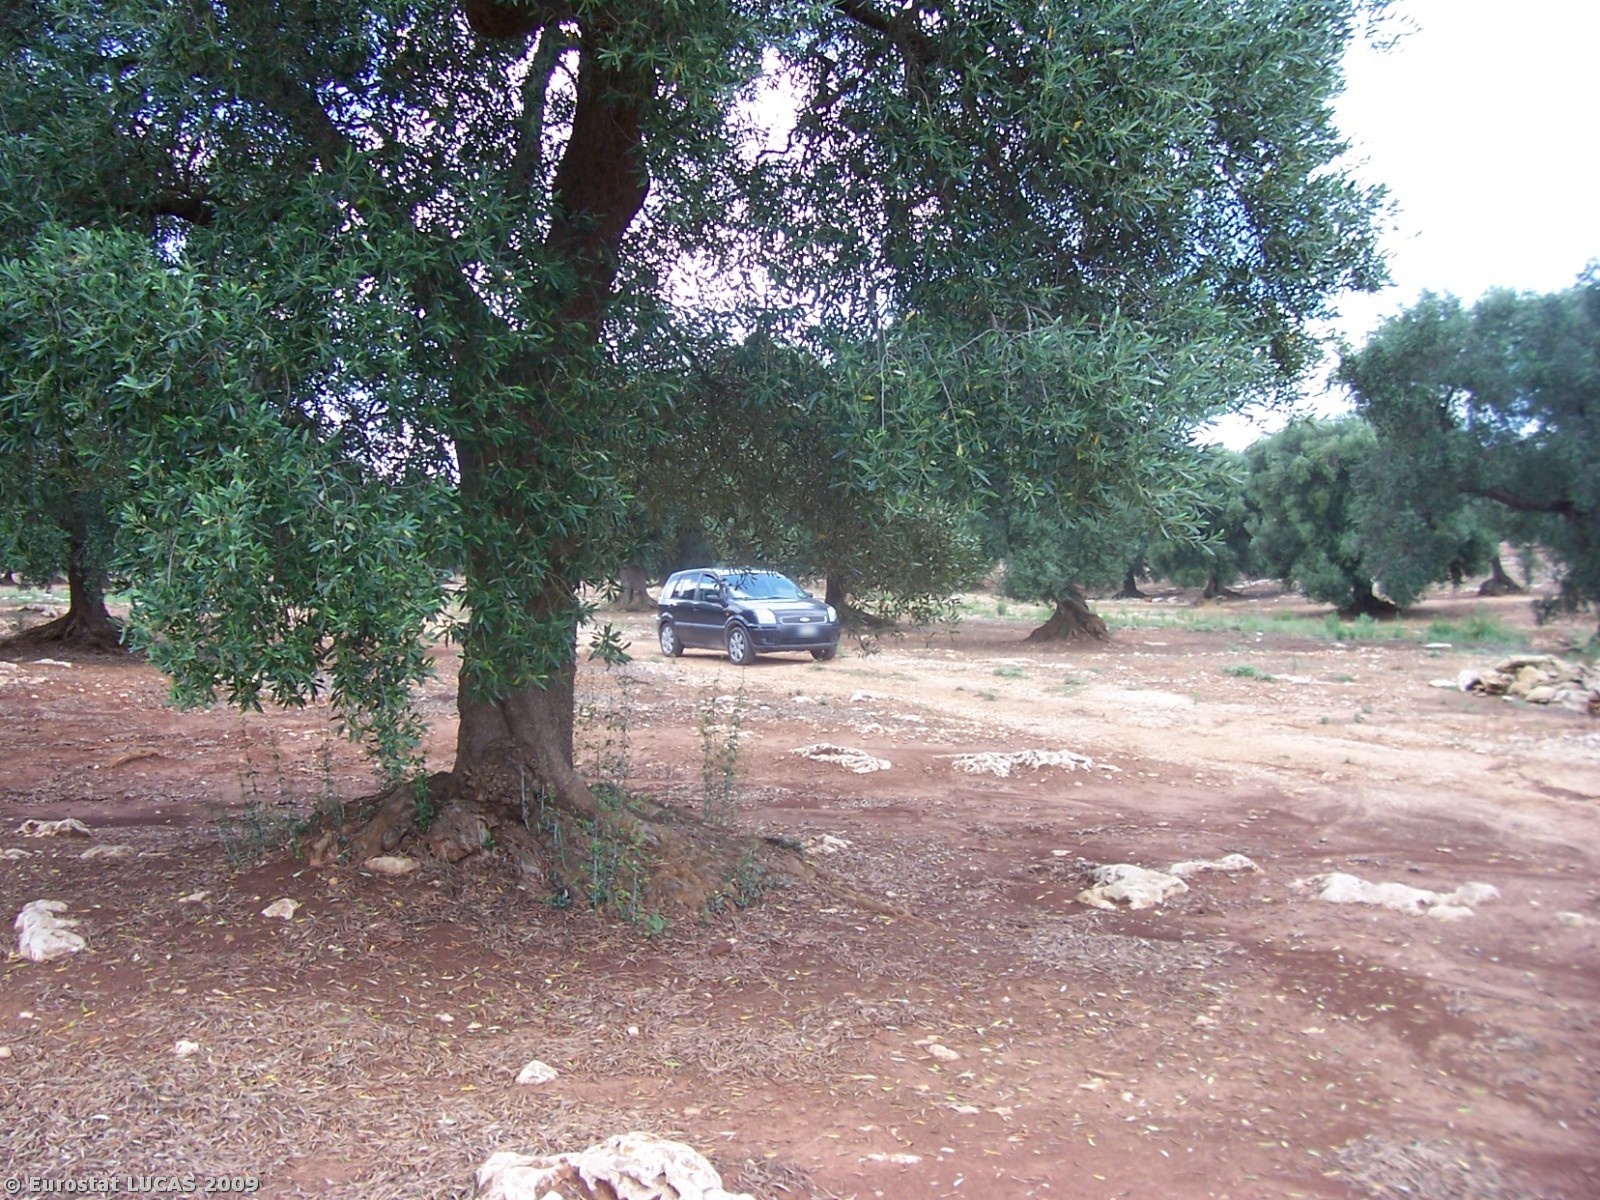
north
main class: Cropland
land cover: Olive groves
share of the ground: 50 - 75 %
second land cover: Bare land
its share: > 75 %
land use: Agriculture (excluding fallow land and kitchen gardens)
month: July
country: IT
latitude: 40.5577
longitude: 17.5463
